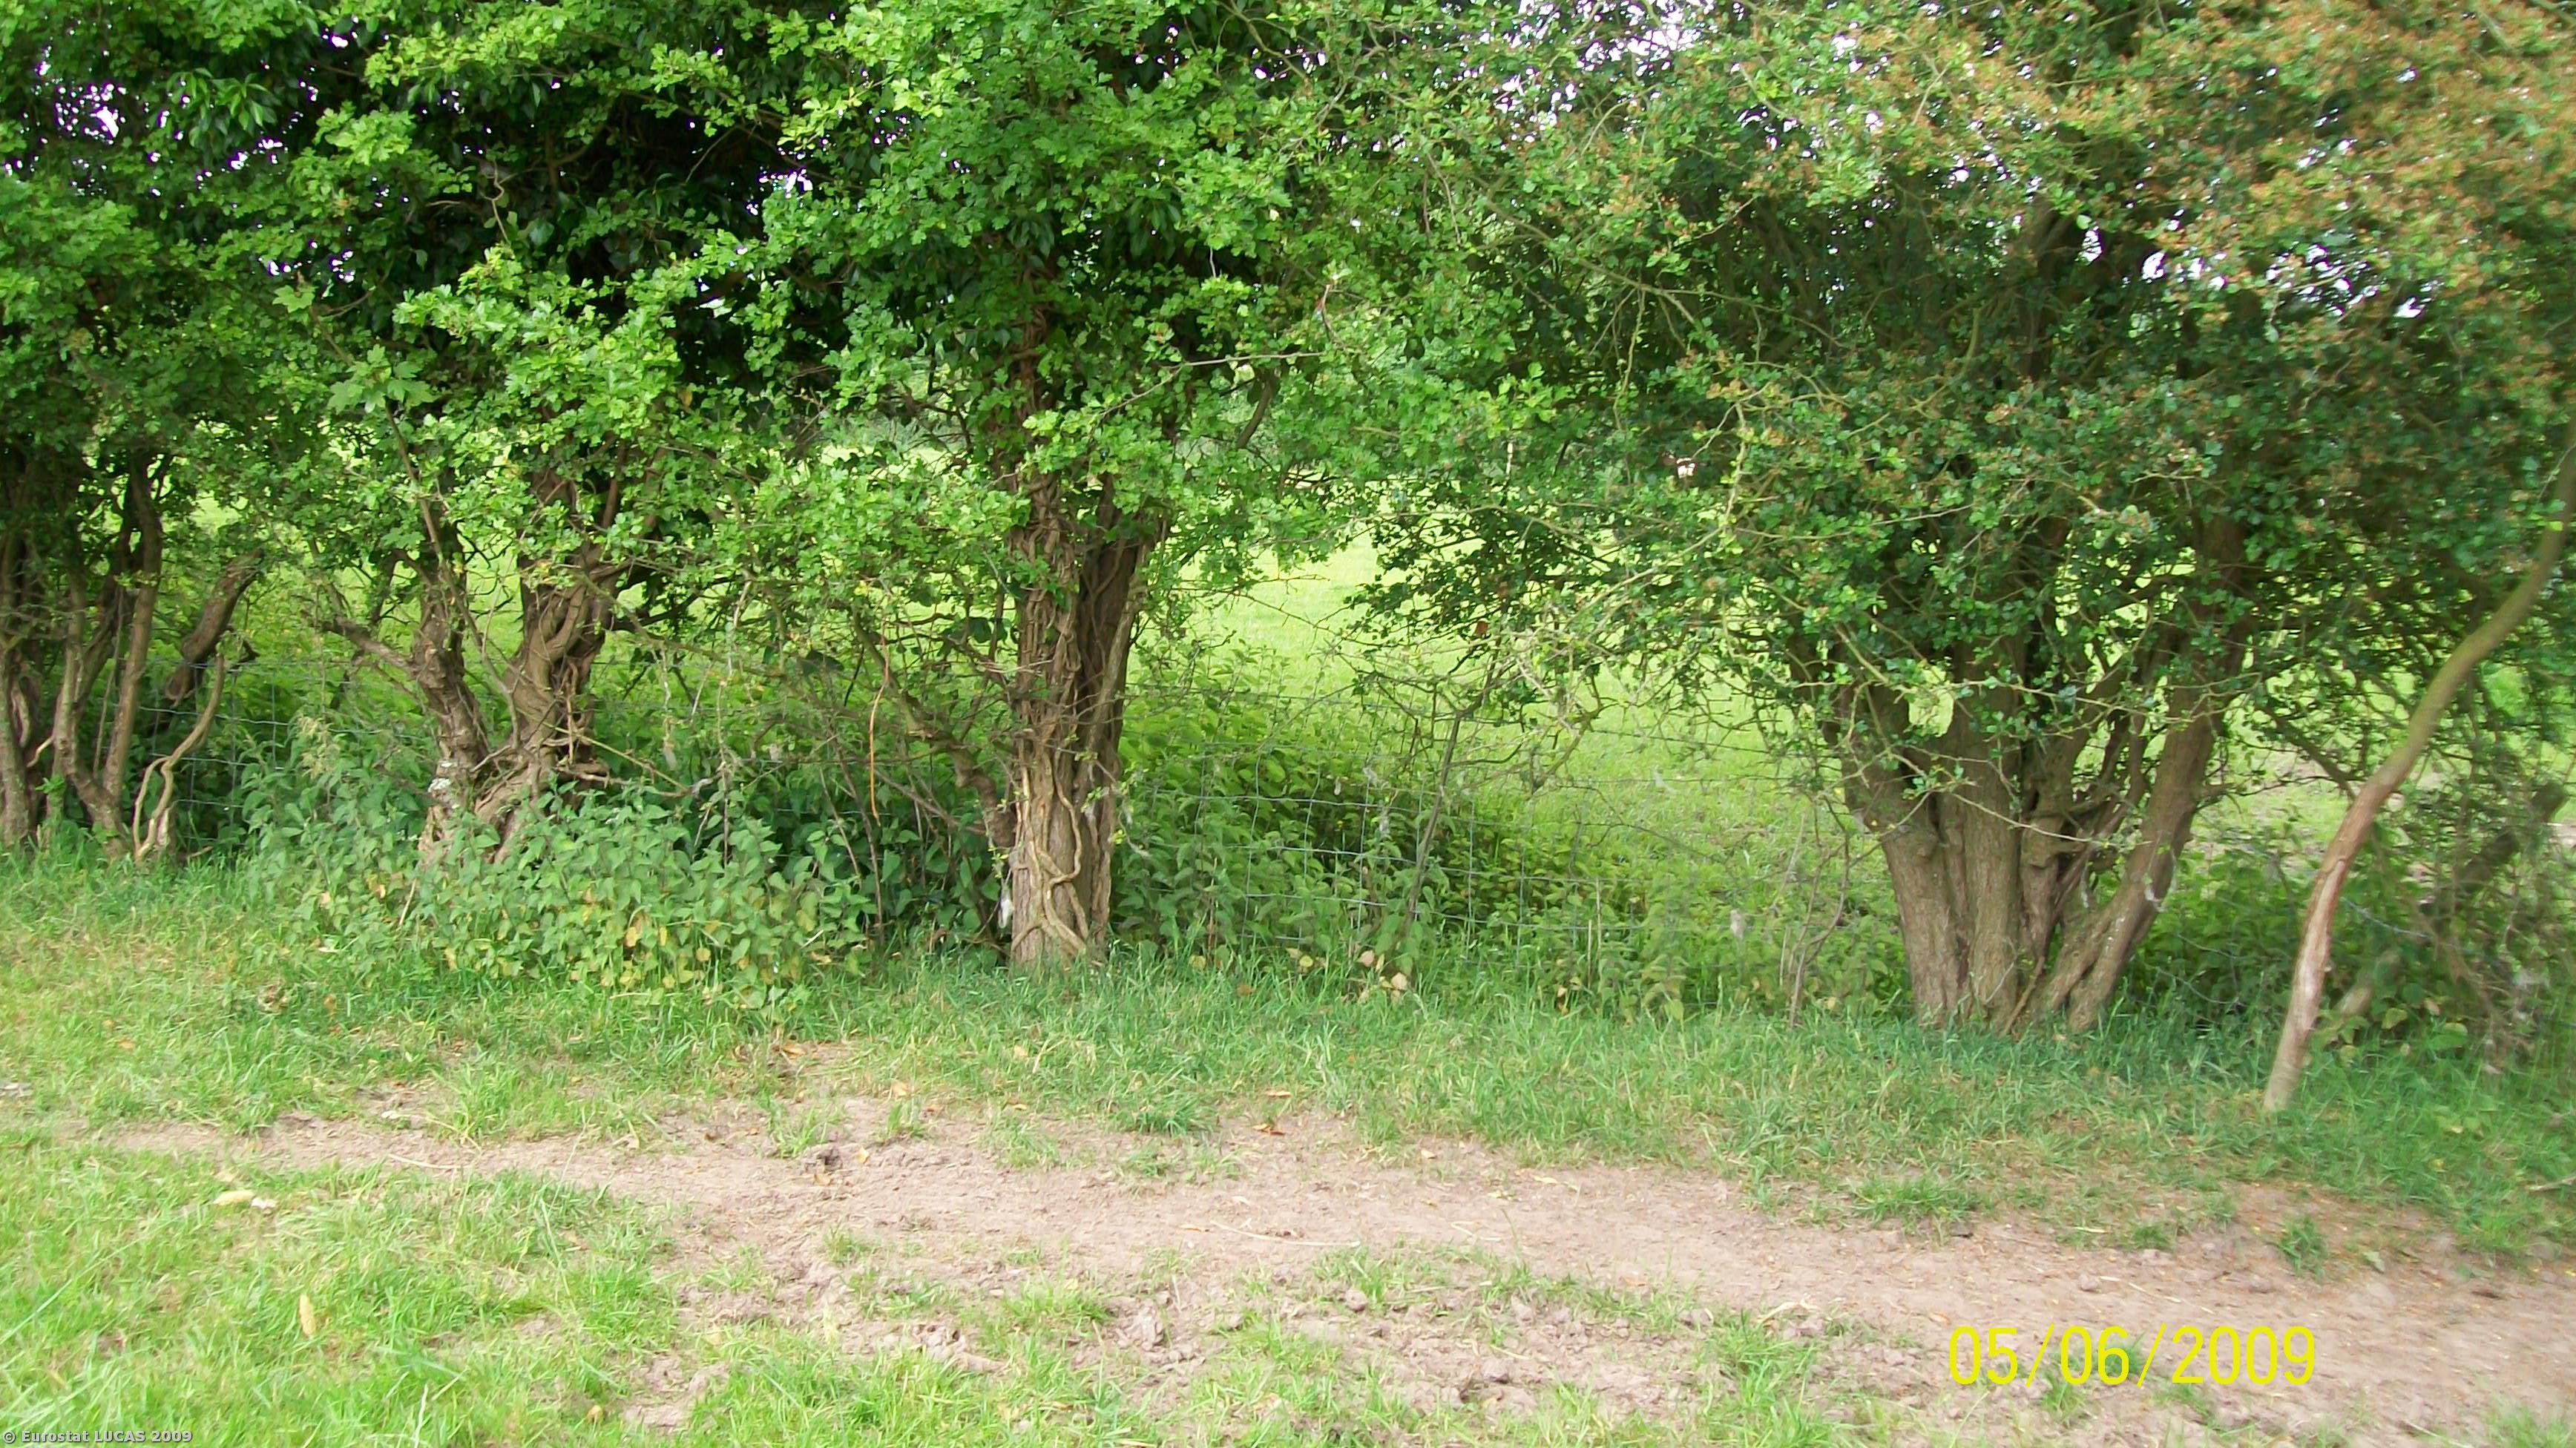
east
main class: Grassland
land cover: Grassland without tree/shrub cover
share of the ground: > 75 %
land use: Agriculture (excluding fallow land and kitchen gardens)
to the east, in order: Grassland without tree/shrub cover; Managed hedges; Grassland without tree/shrub cover; Managed hedges; Grassland without tree/shrub cover; Managed hedges; Grassland without tree/shrub cover
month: June
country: GB
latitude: 53.1243
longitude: -2.7574
